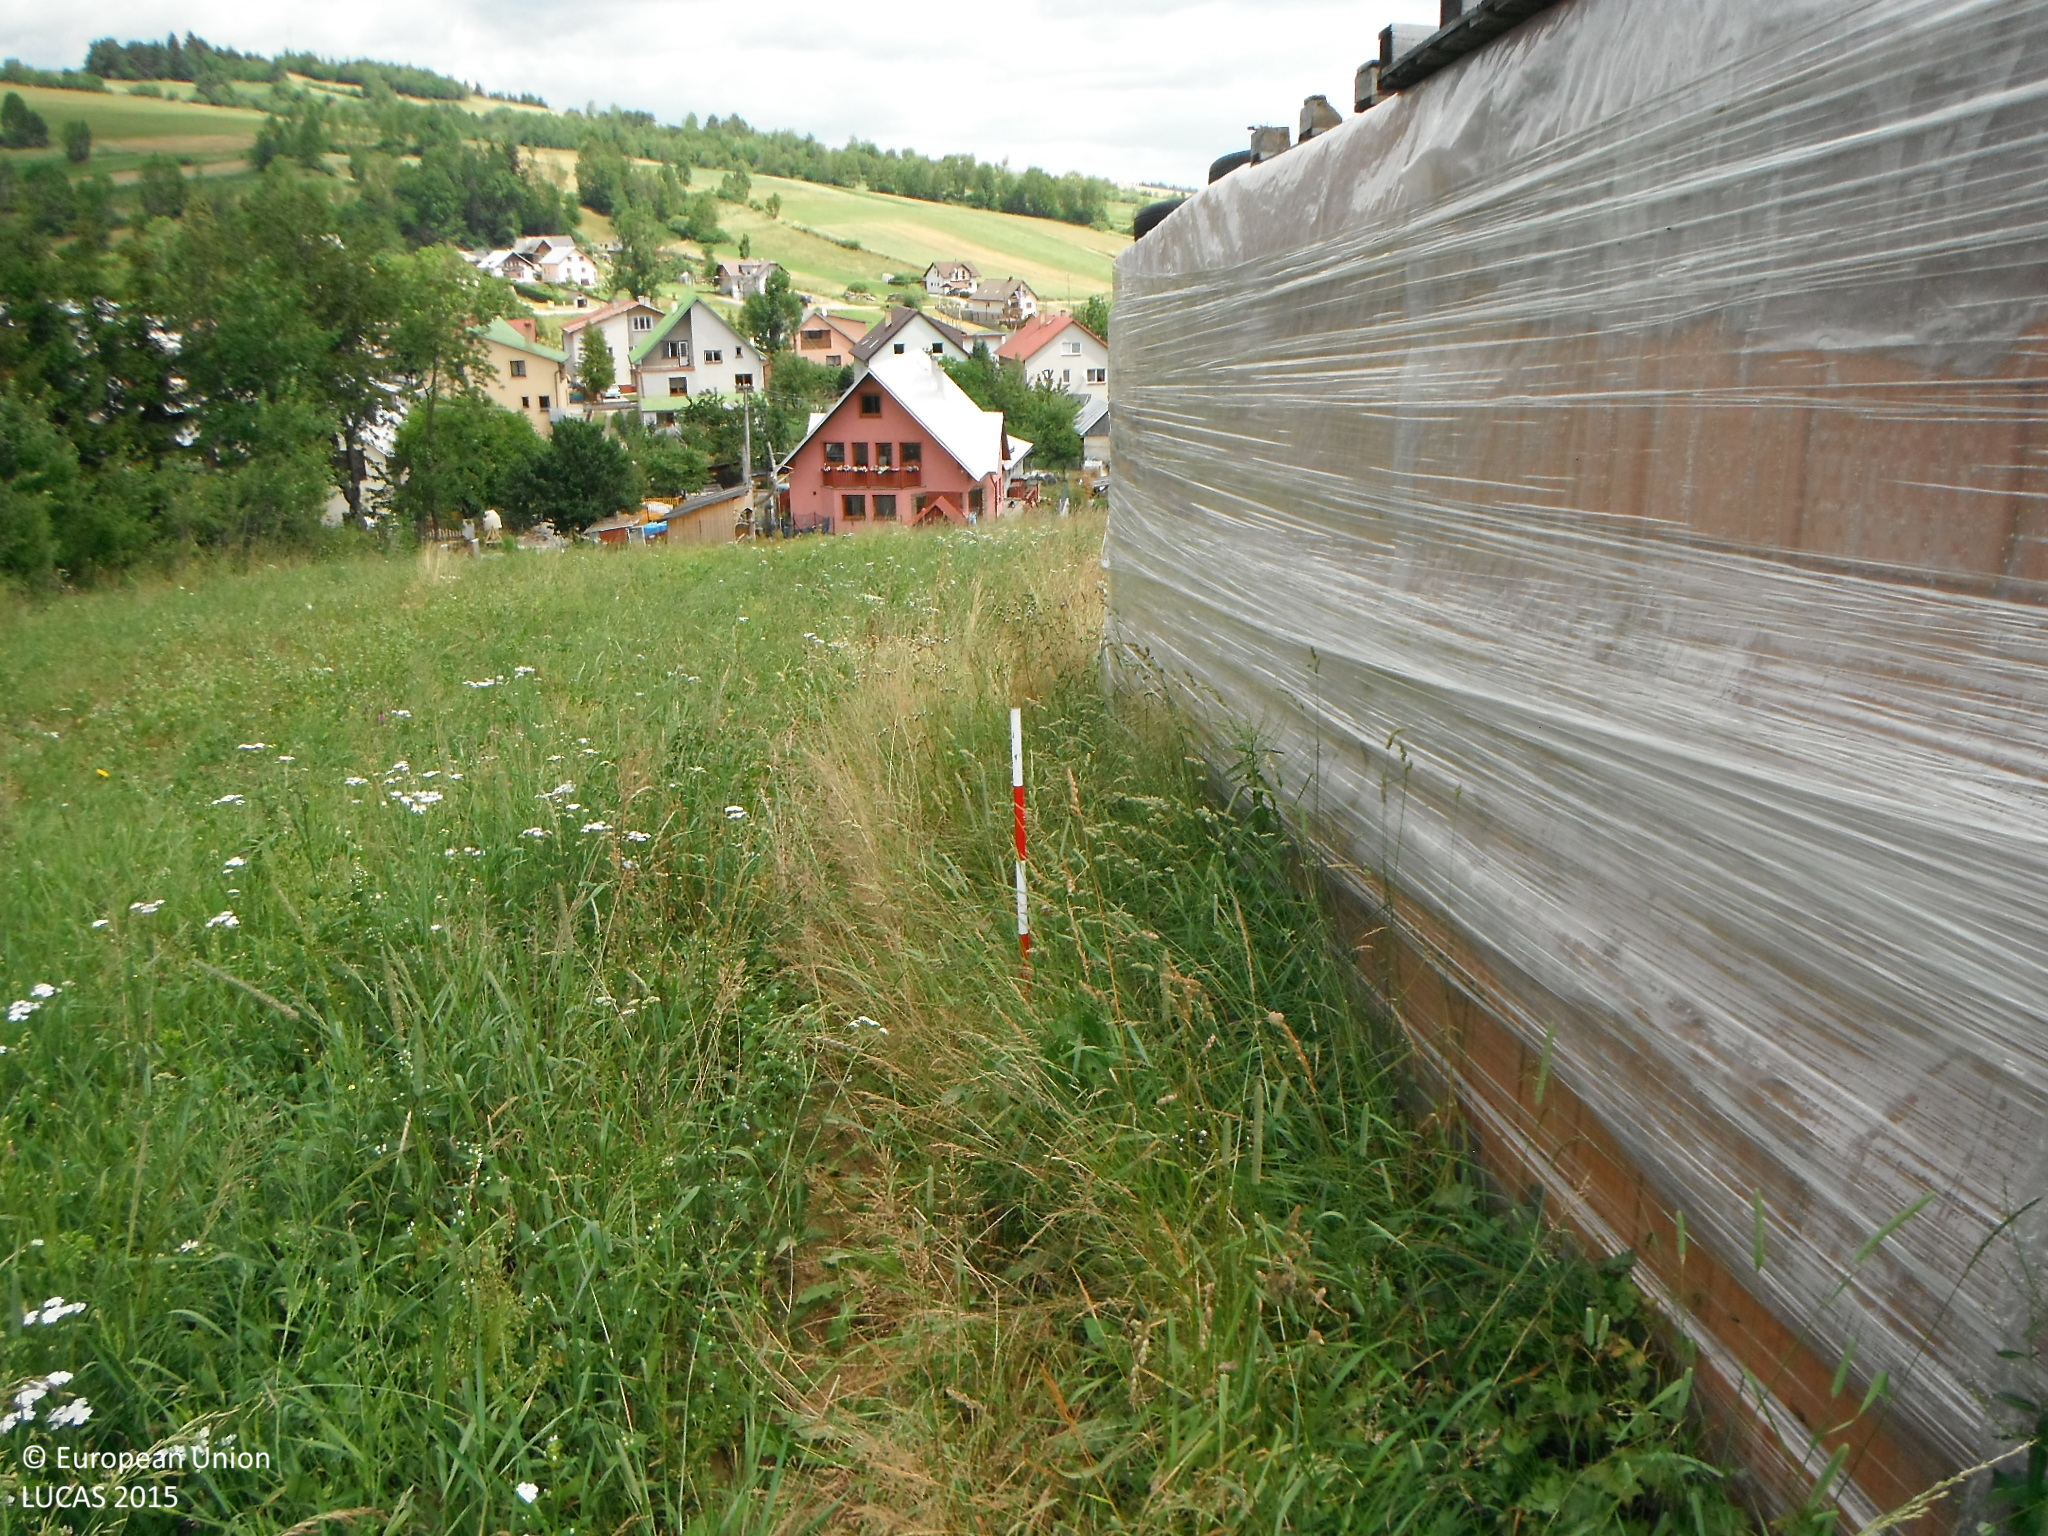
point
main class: Grassland
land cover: Grassland without tree/shrub cover
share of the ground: > 75 %
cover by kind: herbaceous plants 100 %
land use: Agriculture (excluding fallow land and kitchen gardens)
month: July
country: SK
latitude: 49.4449
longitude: 19.4742
